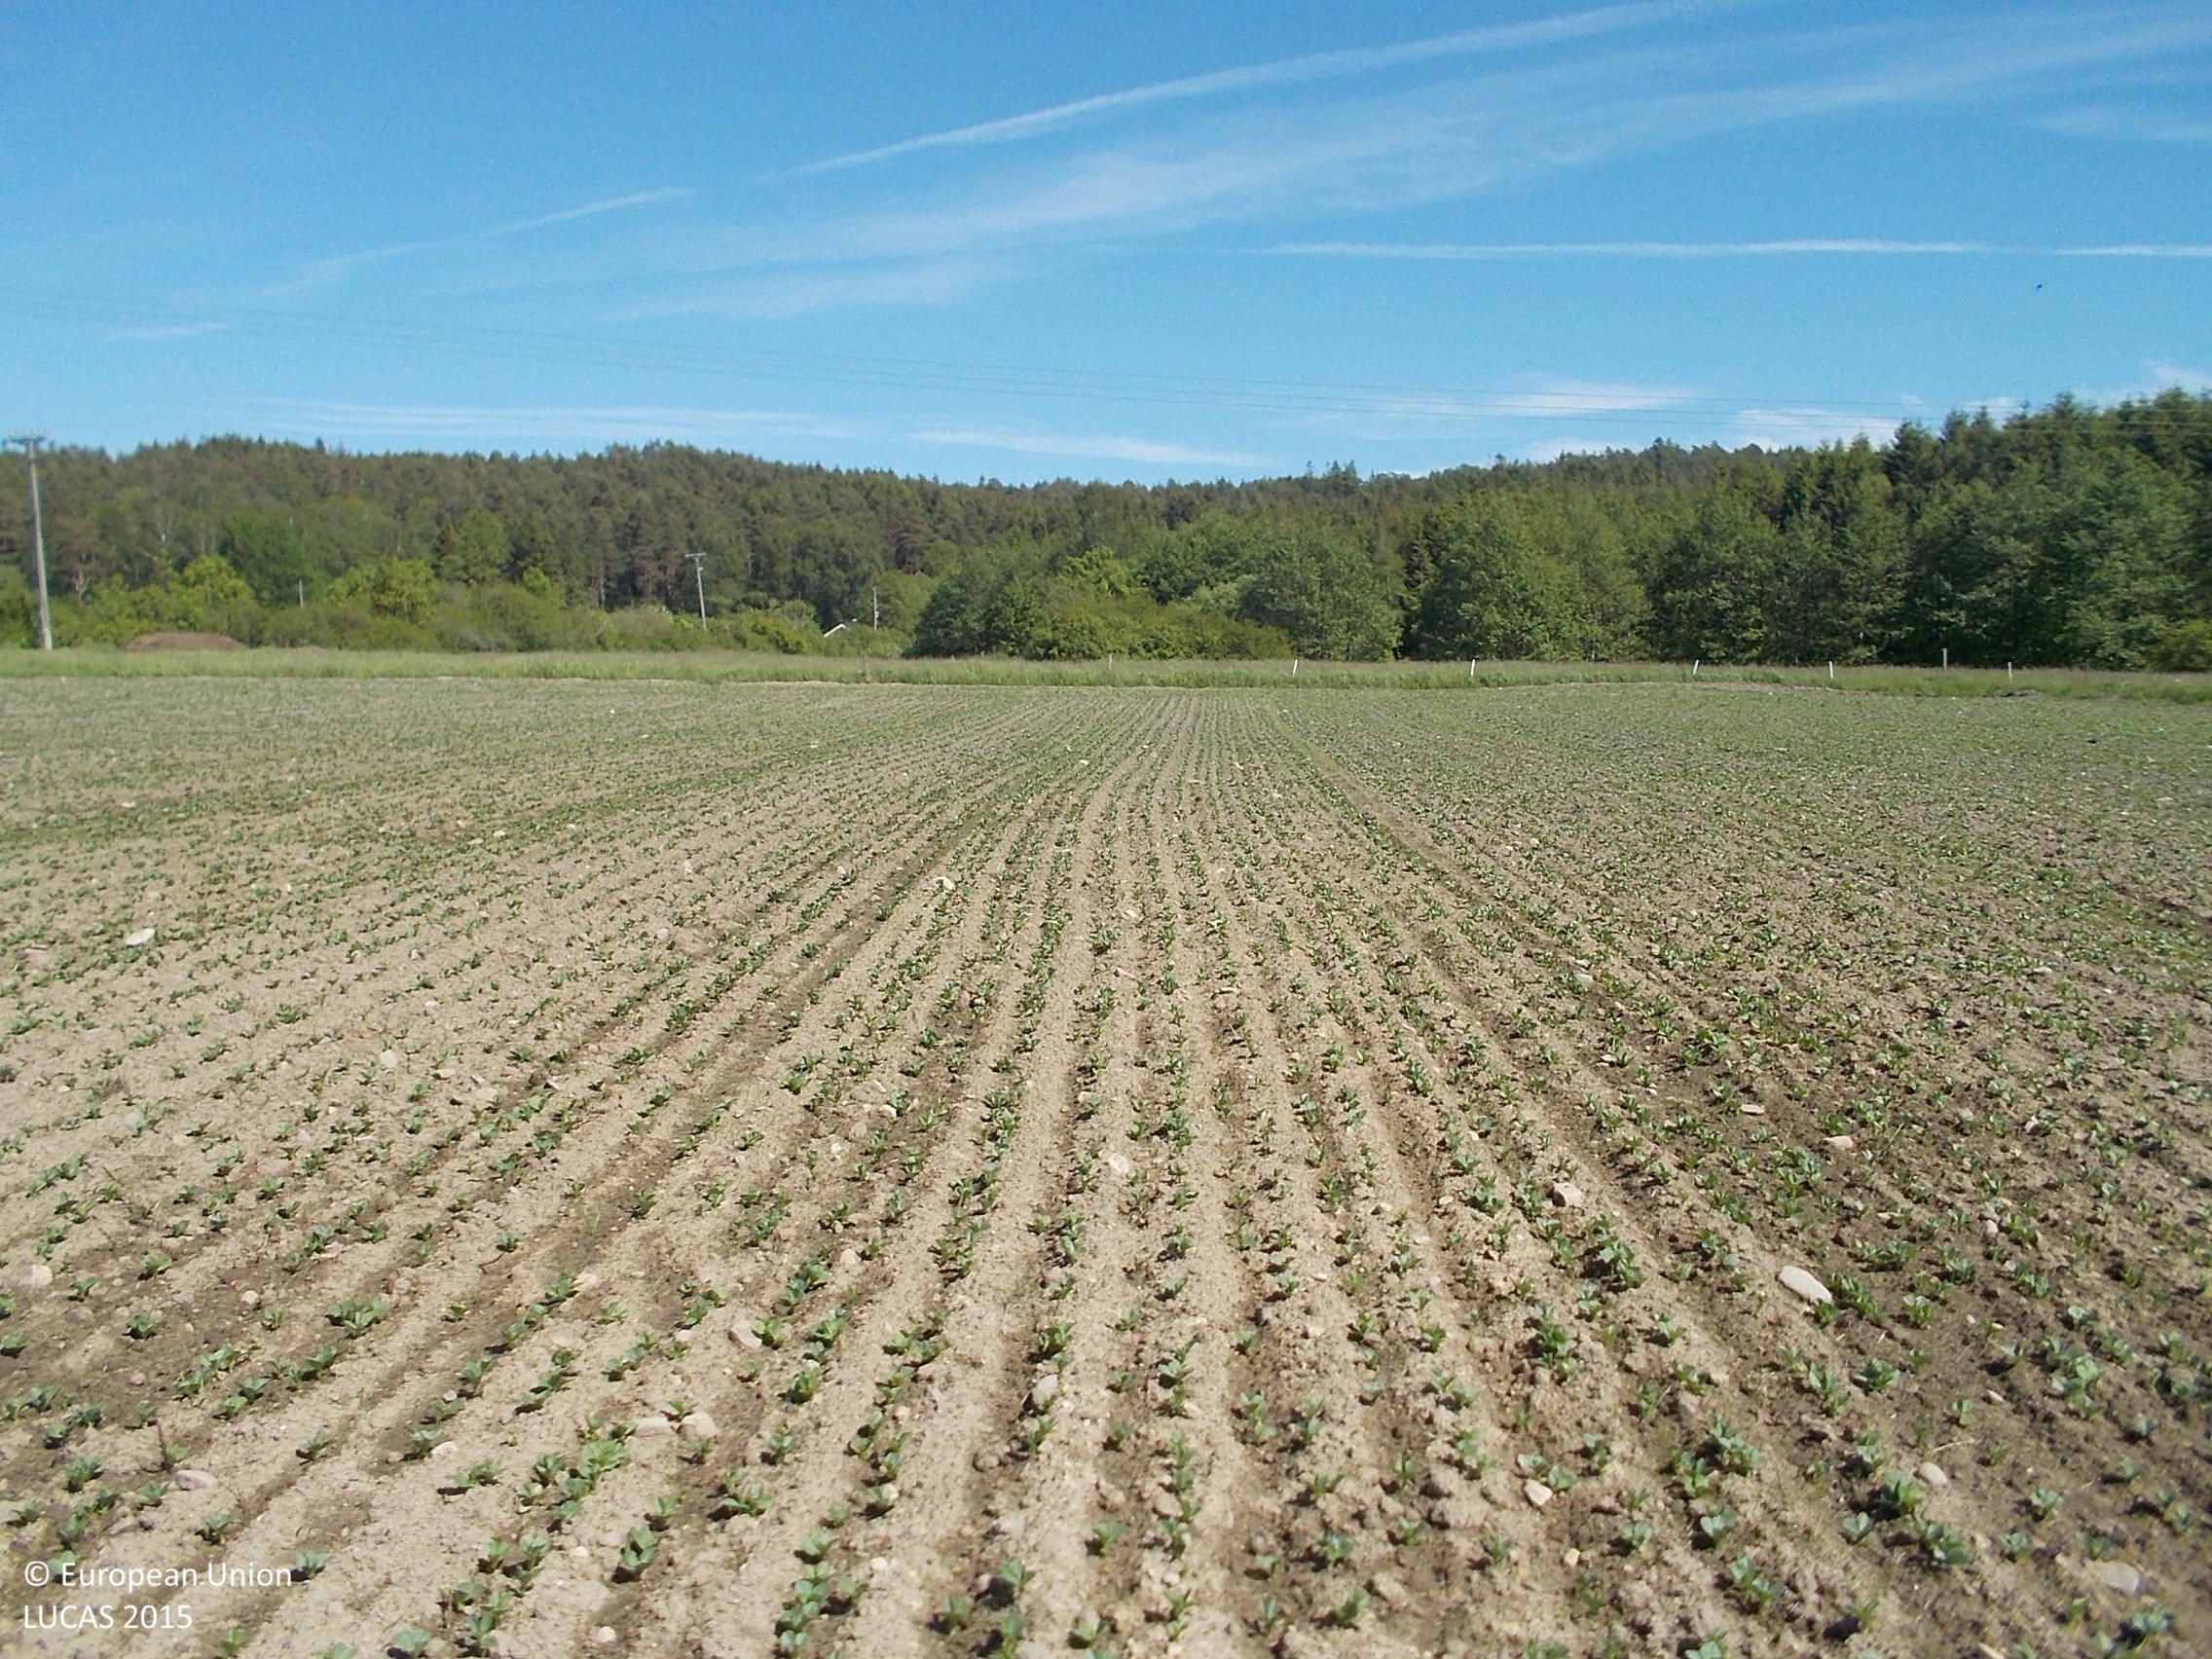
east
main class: Cropland
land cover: Dry pulses
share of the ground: 50 - 75 %
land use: Agriculture (excluding fallow land and kitchen gardens)
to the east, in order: Dry pulses; Fences; Electric lines; Grassland without tree/shrub cover; Shrubland with sparse tree cover; Grassland without tree/shrub cover; Broadleaved woodland; Rivers and streams; Broadleaved woodland; Shrubland with sparse tree cover; Broadleaved woodland
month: June
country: SE
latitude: 57.4103
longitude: 12.1774
